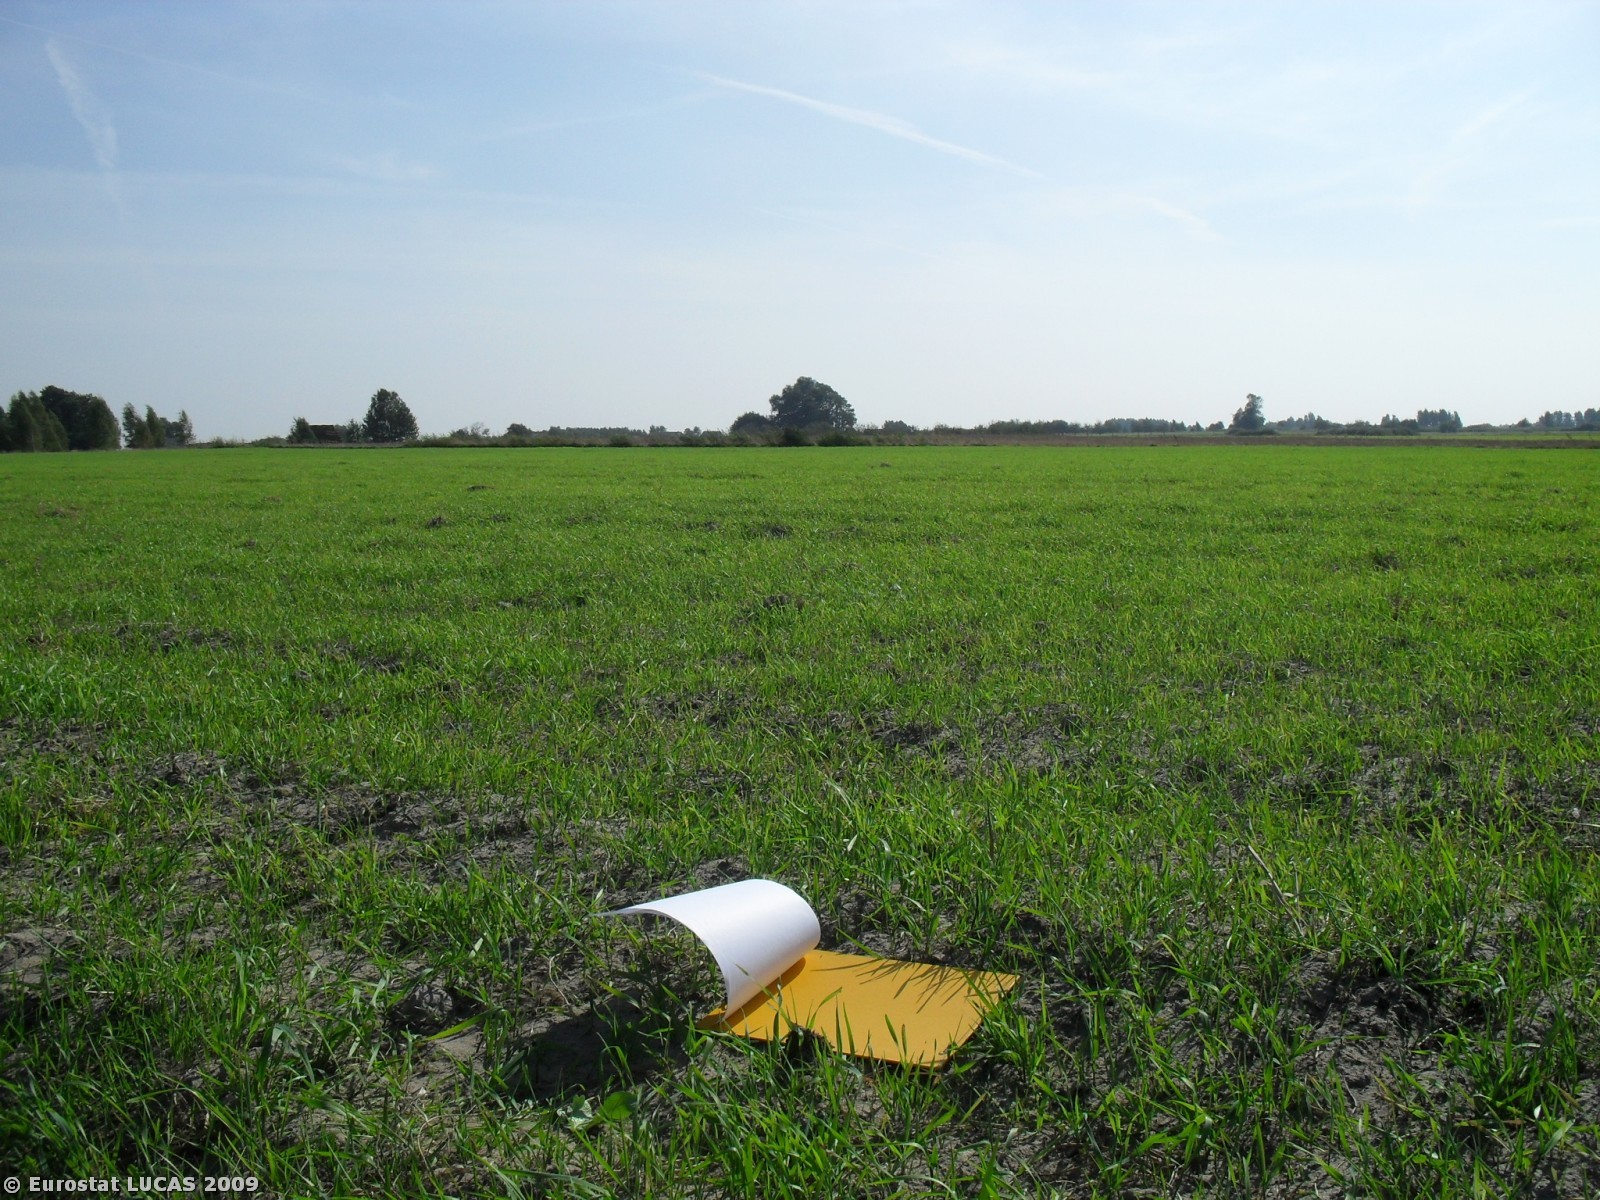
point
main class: Cropland
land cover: Oats
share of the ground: < 10 %
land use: Agriculture (excluding fallow land and kitchen gardens)
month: September
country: PL
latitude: 51.9524
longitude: 21.0303
